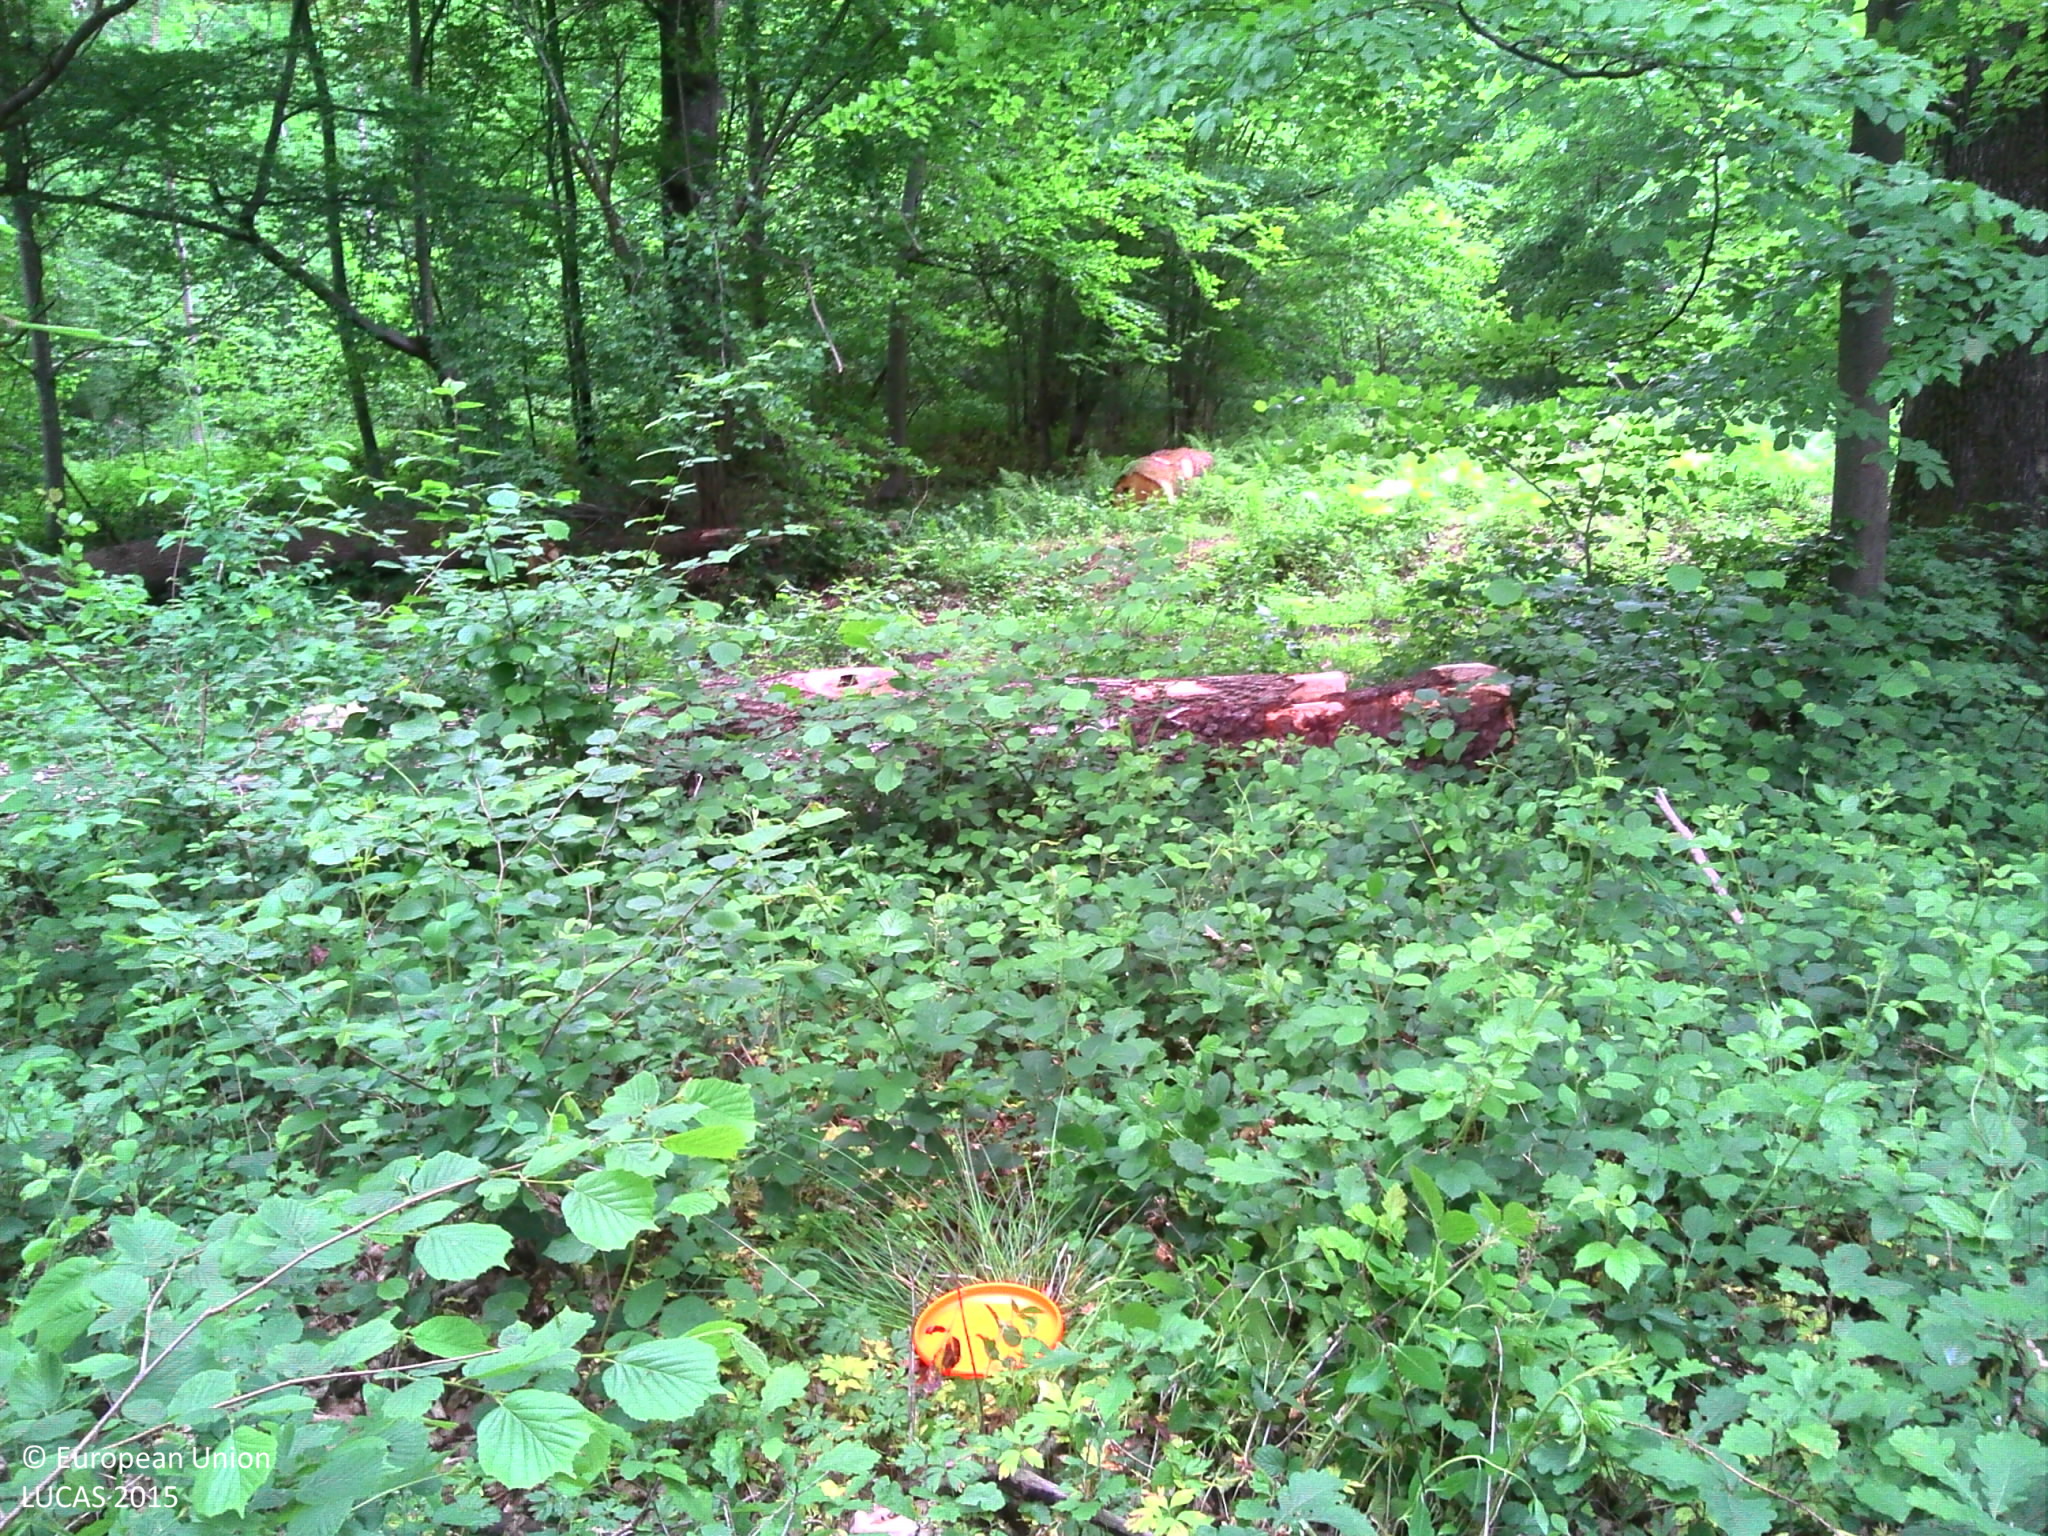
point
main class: Woodland
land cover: Broadleaved woodland
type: acidophilous oak and oak-birch forest
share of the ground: > 75 %
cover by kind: broadleaved forest trees 85 %, herbaceous plants 15 %
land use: Forestry
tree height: > 5 m
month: June
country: BE
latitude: 50.4053
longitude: 5.5944
